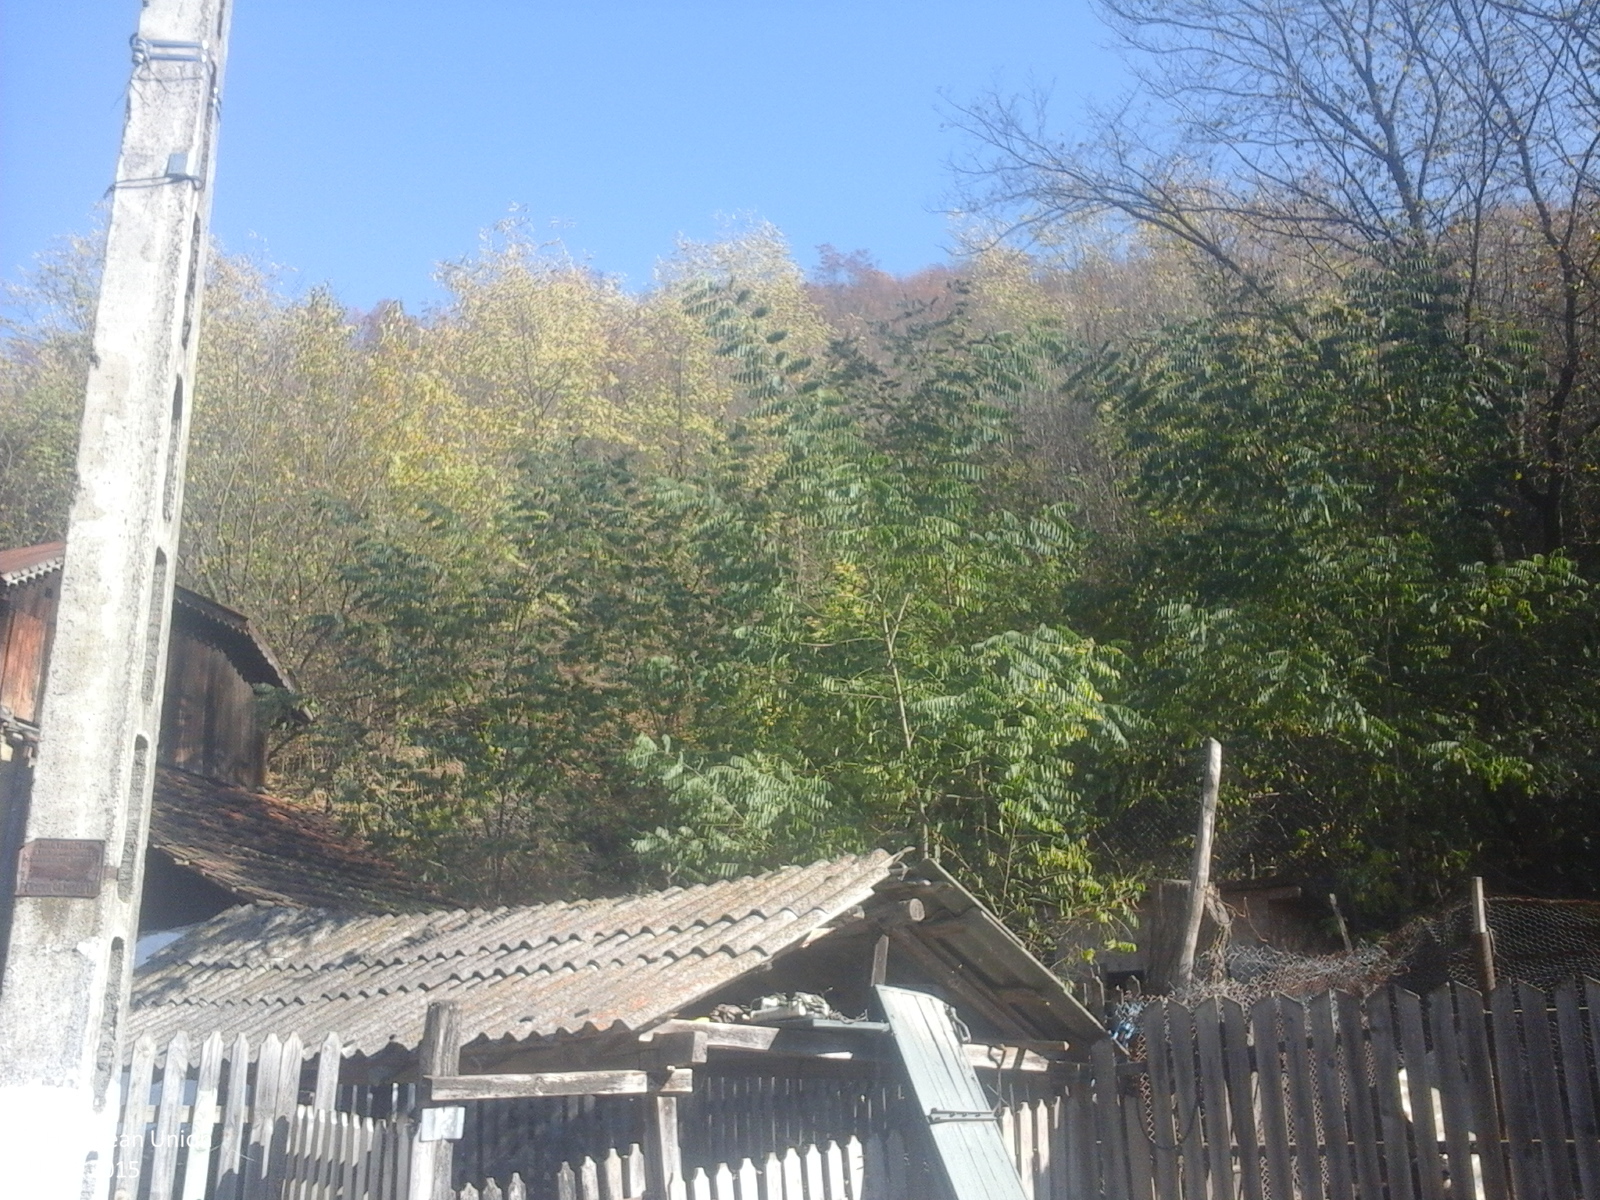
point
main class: Woodland
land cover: Broadleaved woodland
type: beech forest
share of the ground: > 75 %
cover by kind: broadleaved forest trees 100 %
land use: Forestry
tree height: > 5 m
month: October
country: RO
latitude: 45.3729
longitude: 26.7170
